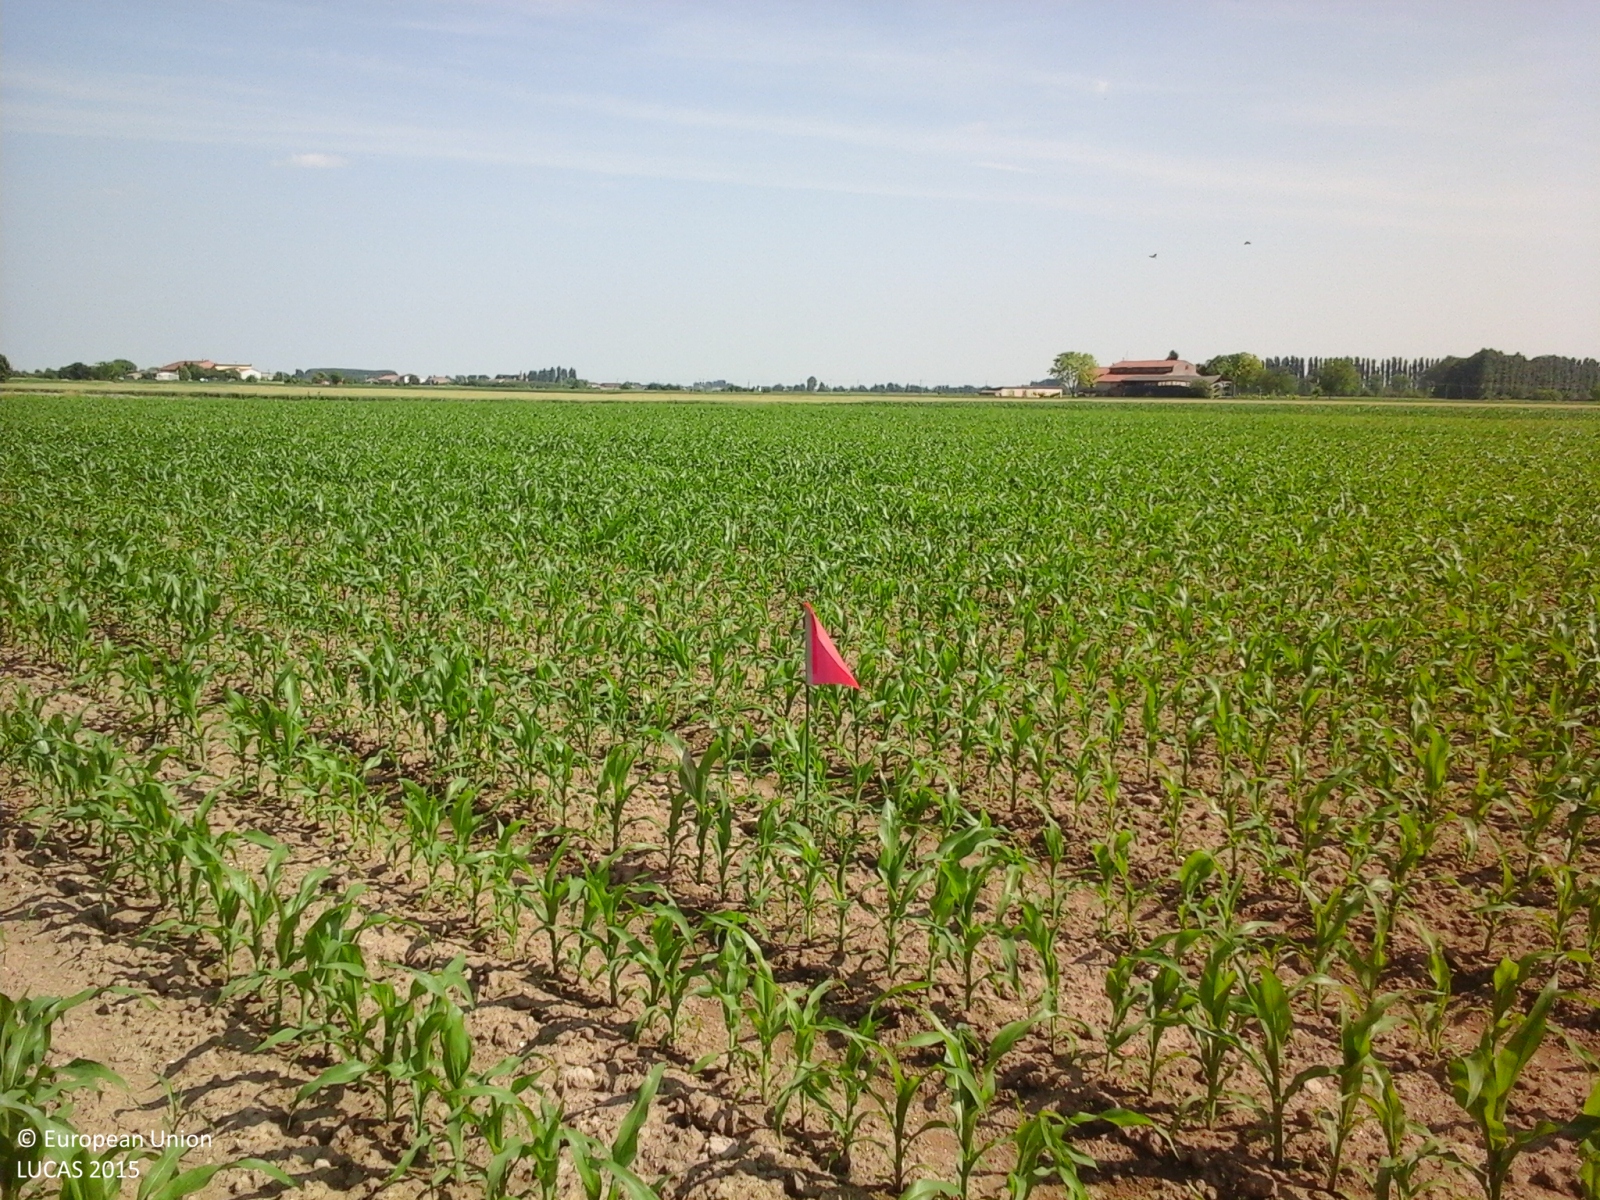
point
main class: Cropland
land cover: Maize
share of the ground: 25 - 50 %
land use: Agriculture (excluding fallow land and kitchen gardens)
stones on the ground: < 10 %
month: May
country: IT
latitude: 45.2119
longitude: 10.9278
